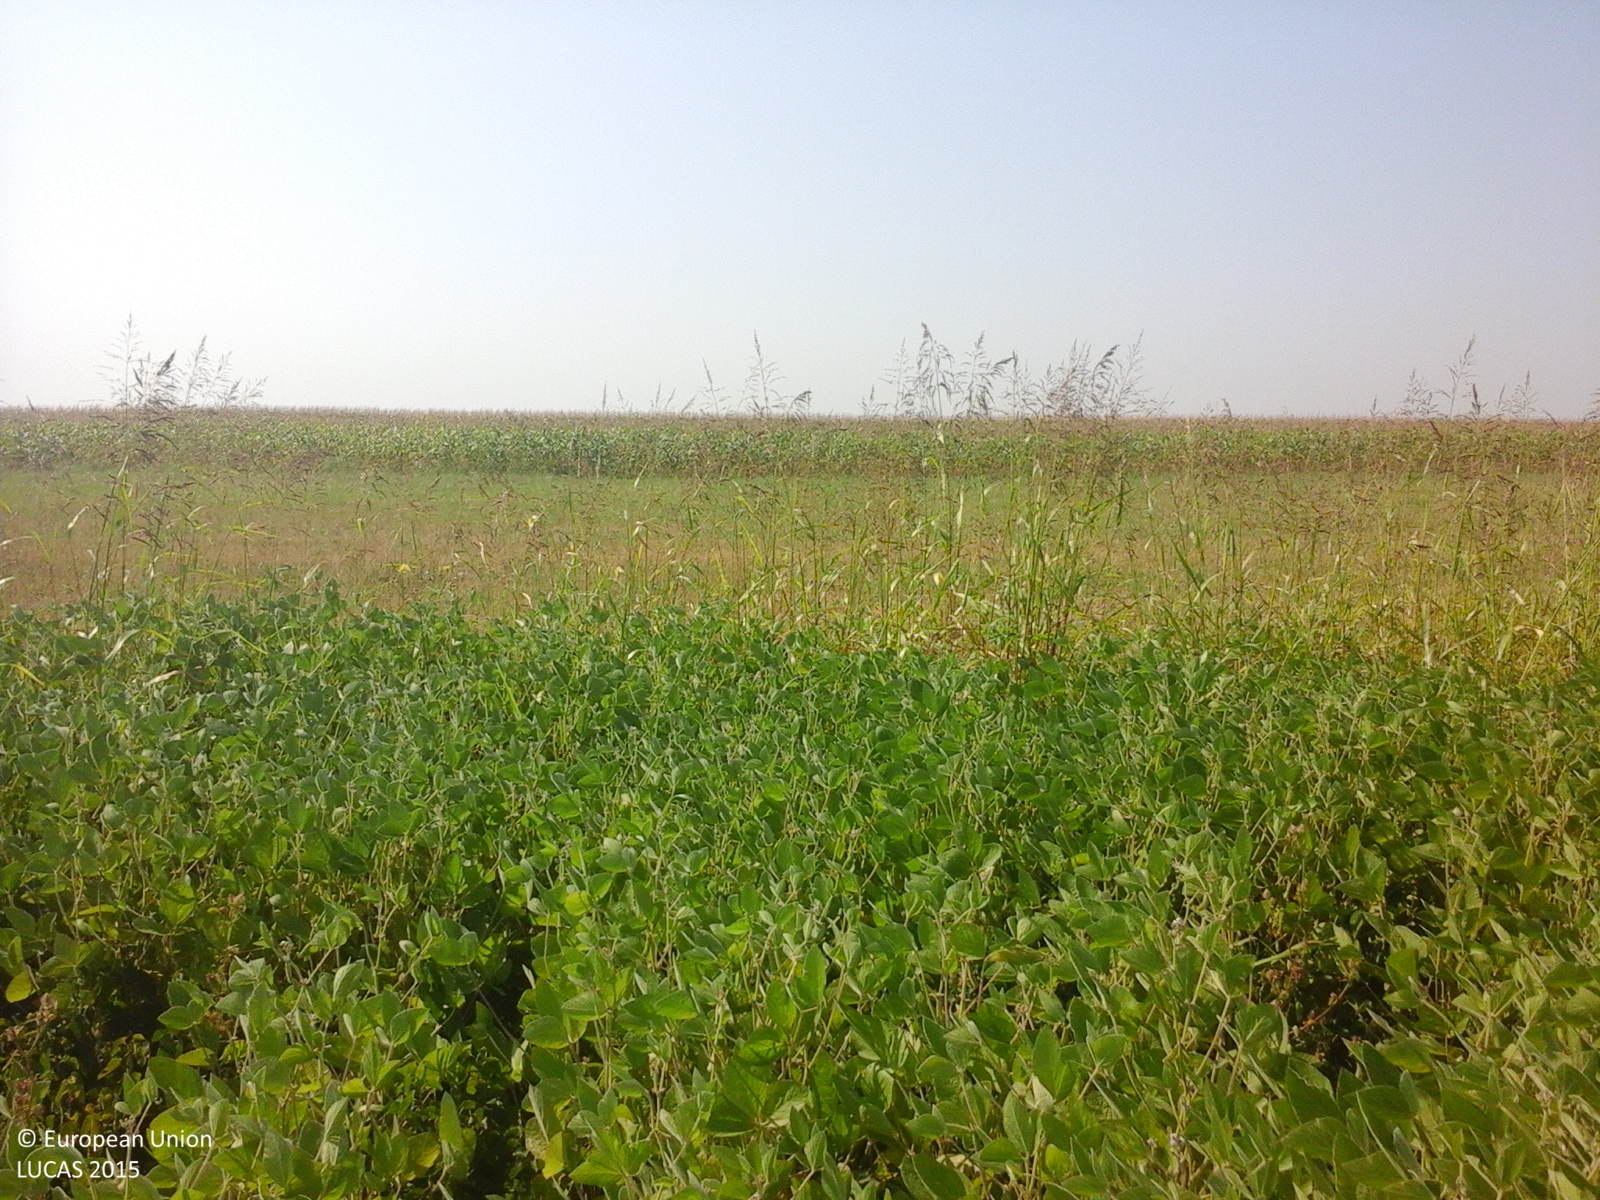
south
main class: Cropland
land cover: Soya
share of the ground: > 75 %
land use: Agriculture (excluding fallow land and kitchen gardens)
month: August
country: RO
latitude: 45.0966
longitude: 27.3899
